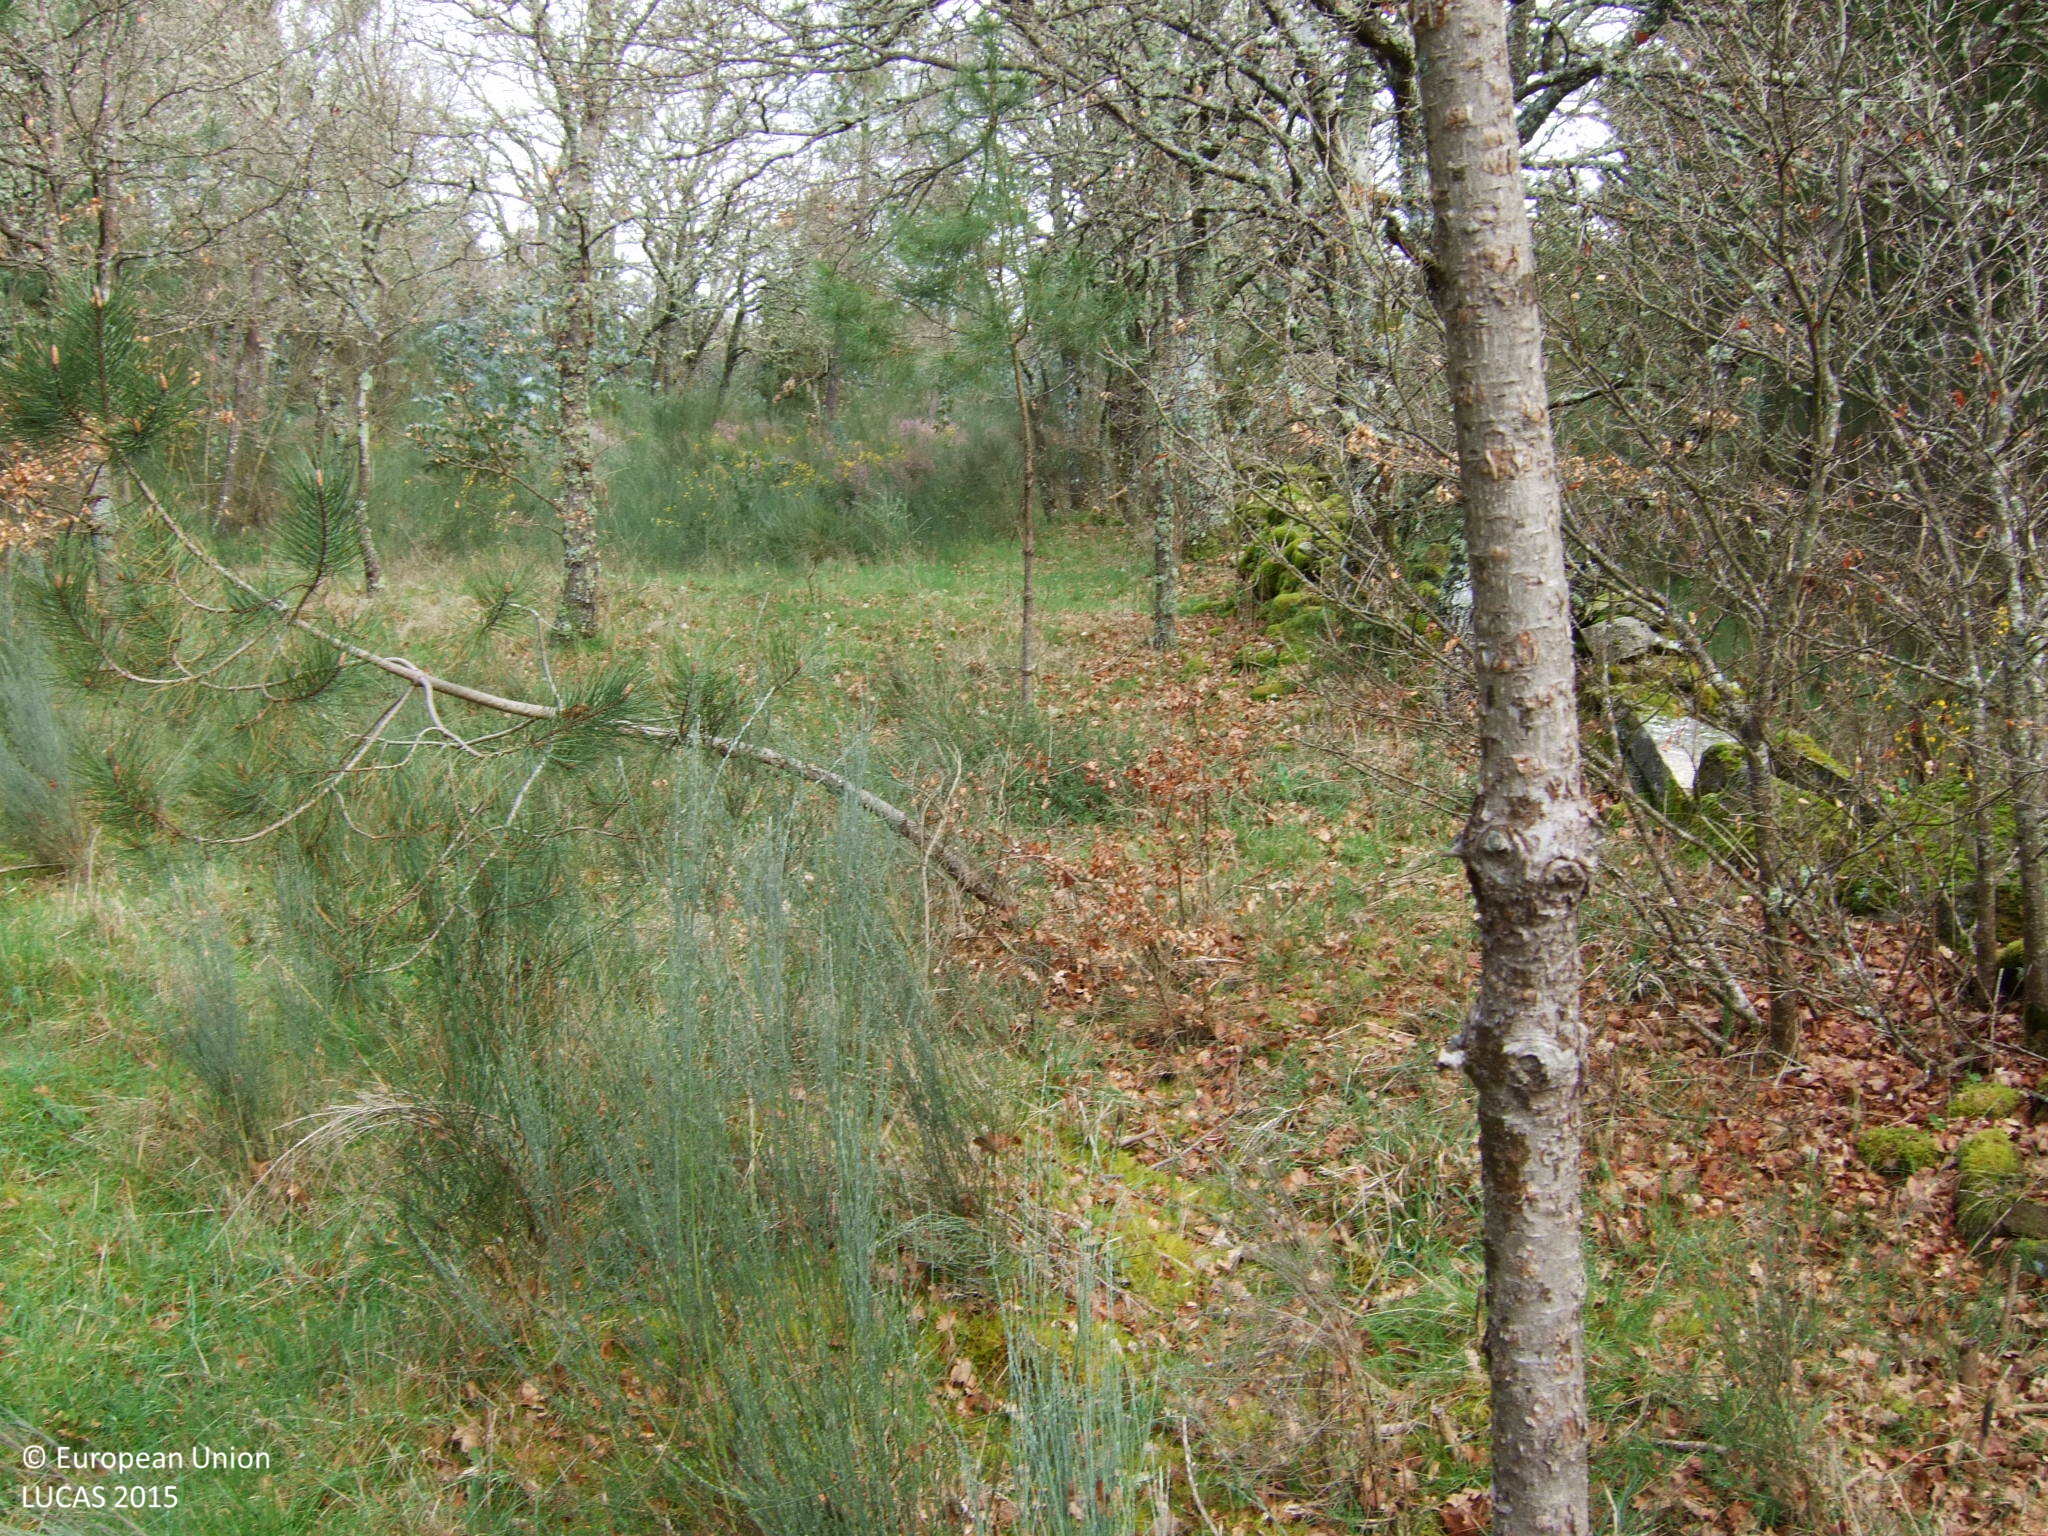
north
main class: Woodland
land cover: Pine dominated coniferous woodland
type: exotic forest
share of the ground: > 75 %
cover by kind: coniferous forest trees 80 %, shrubs 10 %, herbaceous plants 10 %
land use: Forestry
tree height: > 5 m
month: March
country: ES
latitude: 42.8099
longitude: -7.8267
